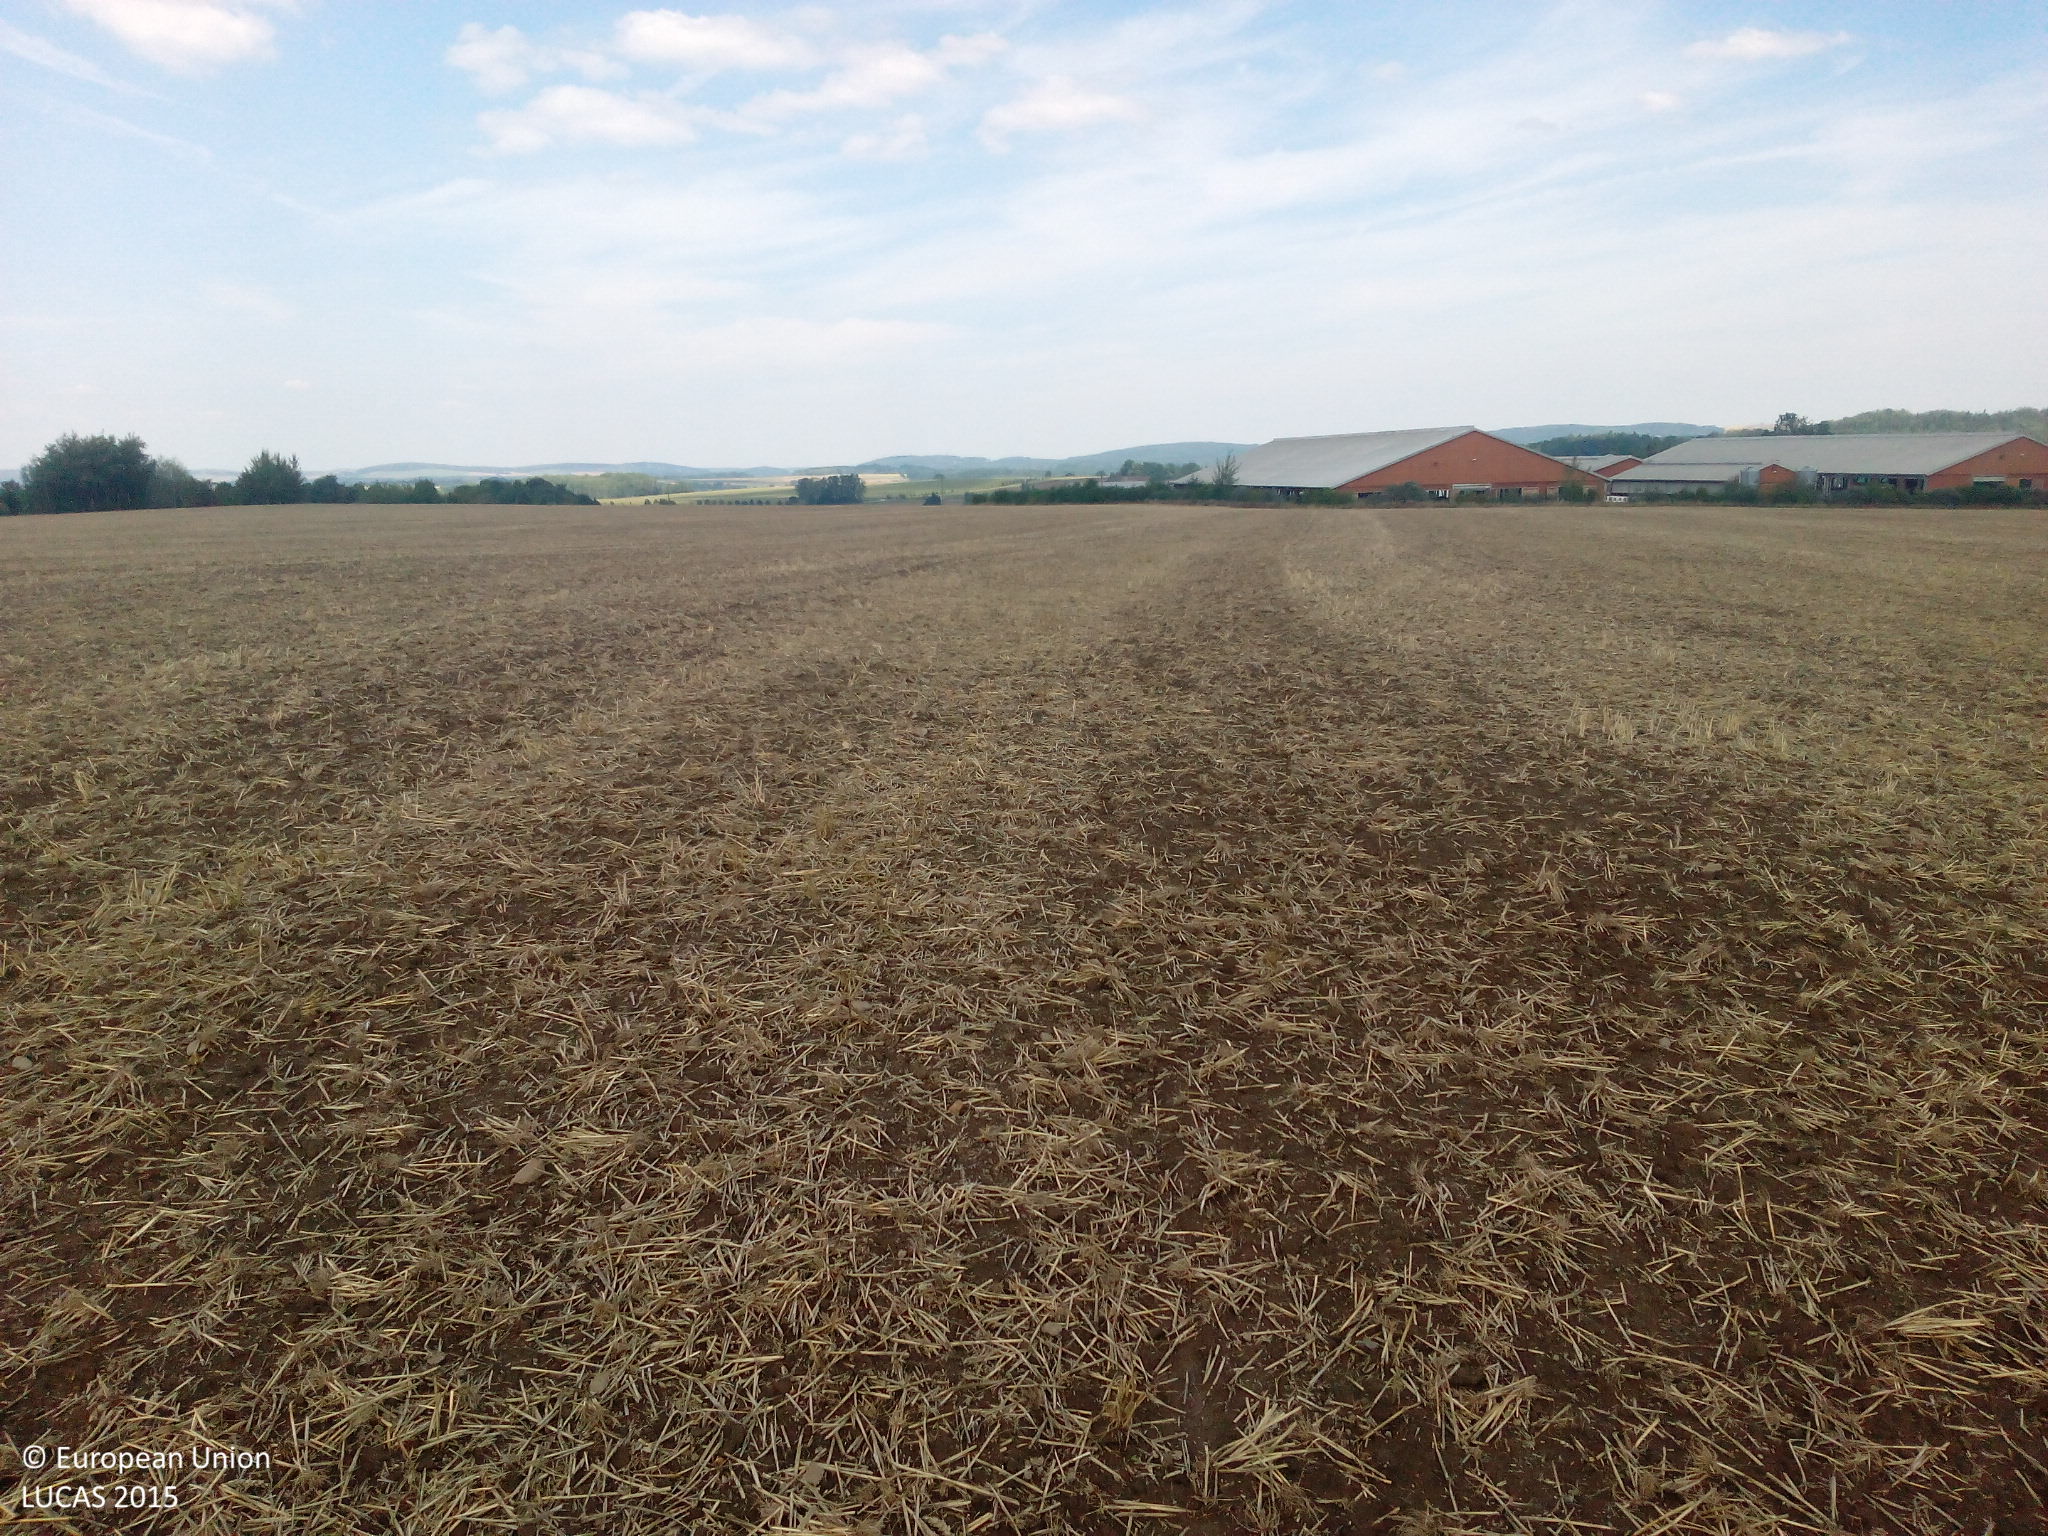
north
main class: Cropland
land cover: Common wheat
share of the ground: 10 - 25 %
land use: Agriculture (excluding fallow land and kitchen gardens)
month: August
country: DE
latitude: 50.9233
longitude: 14.0271
